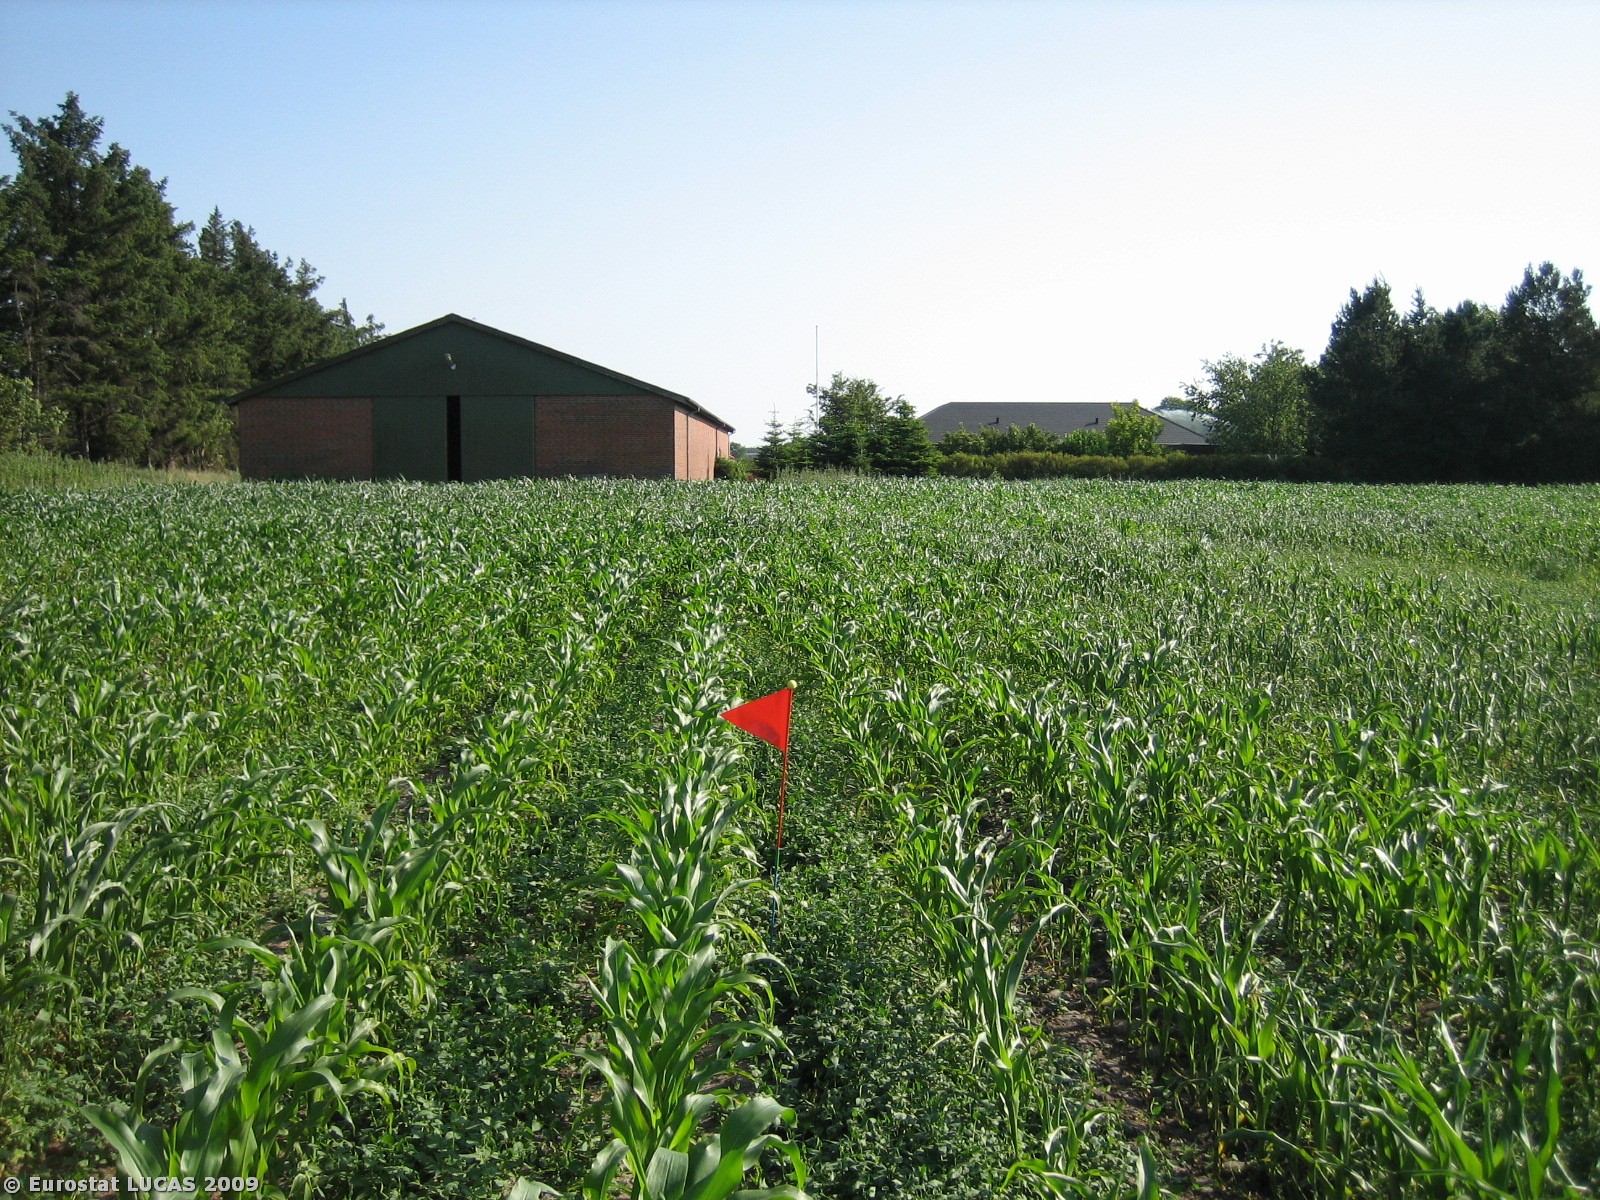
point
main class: Cropland
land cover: Maize
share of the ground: 25 - 50 %
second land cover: Dry pulses
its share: 50 - 75 %
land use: Agriculture (excluding fallow land and kitchen gardens)
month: July
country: DK
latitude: 55.3380
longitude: 8.8816
